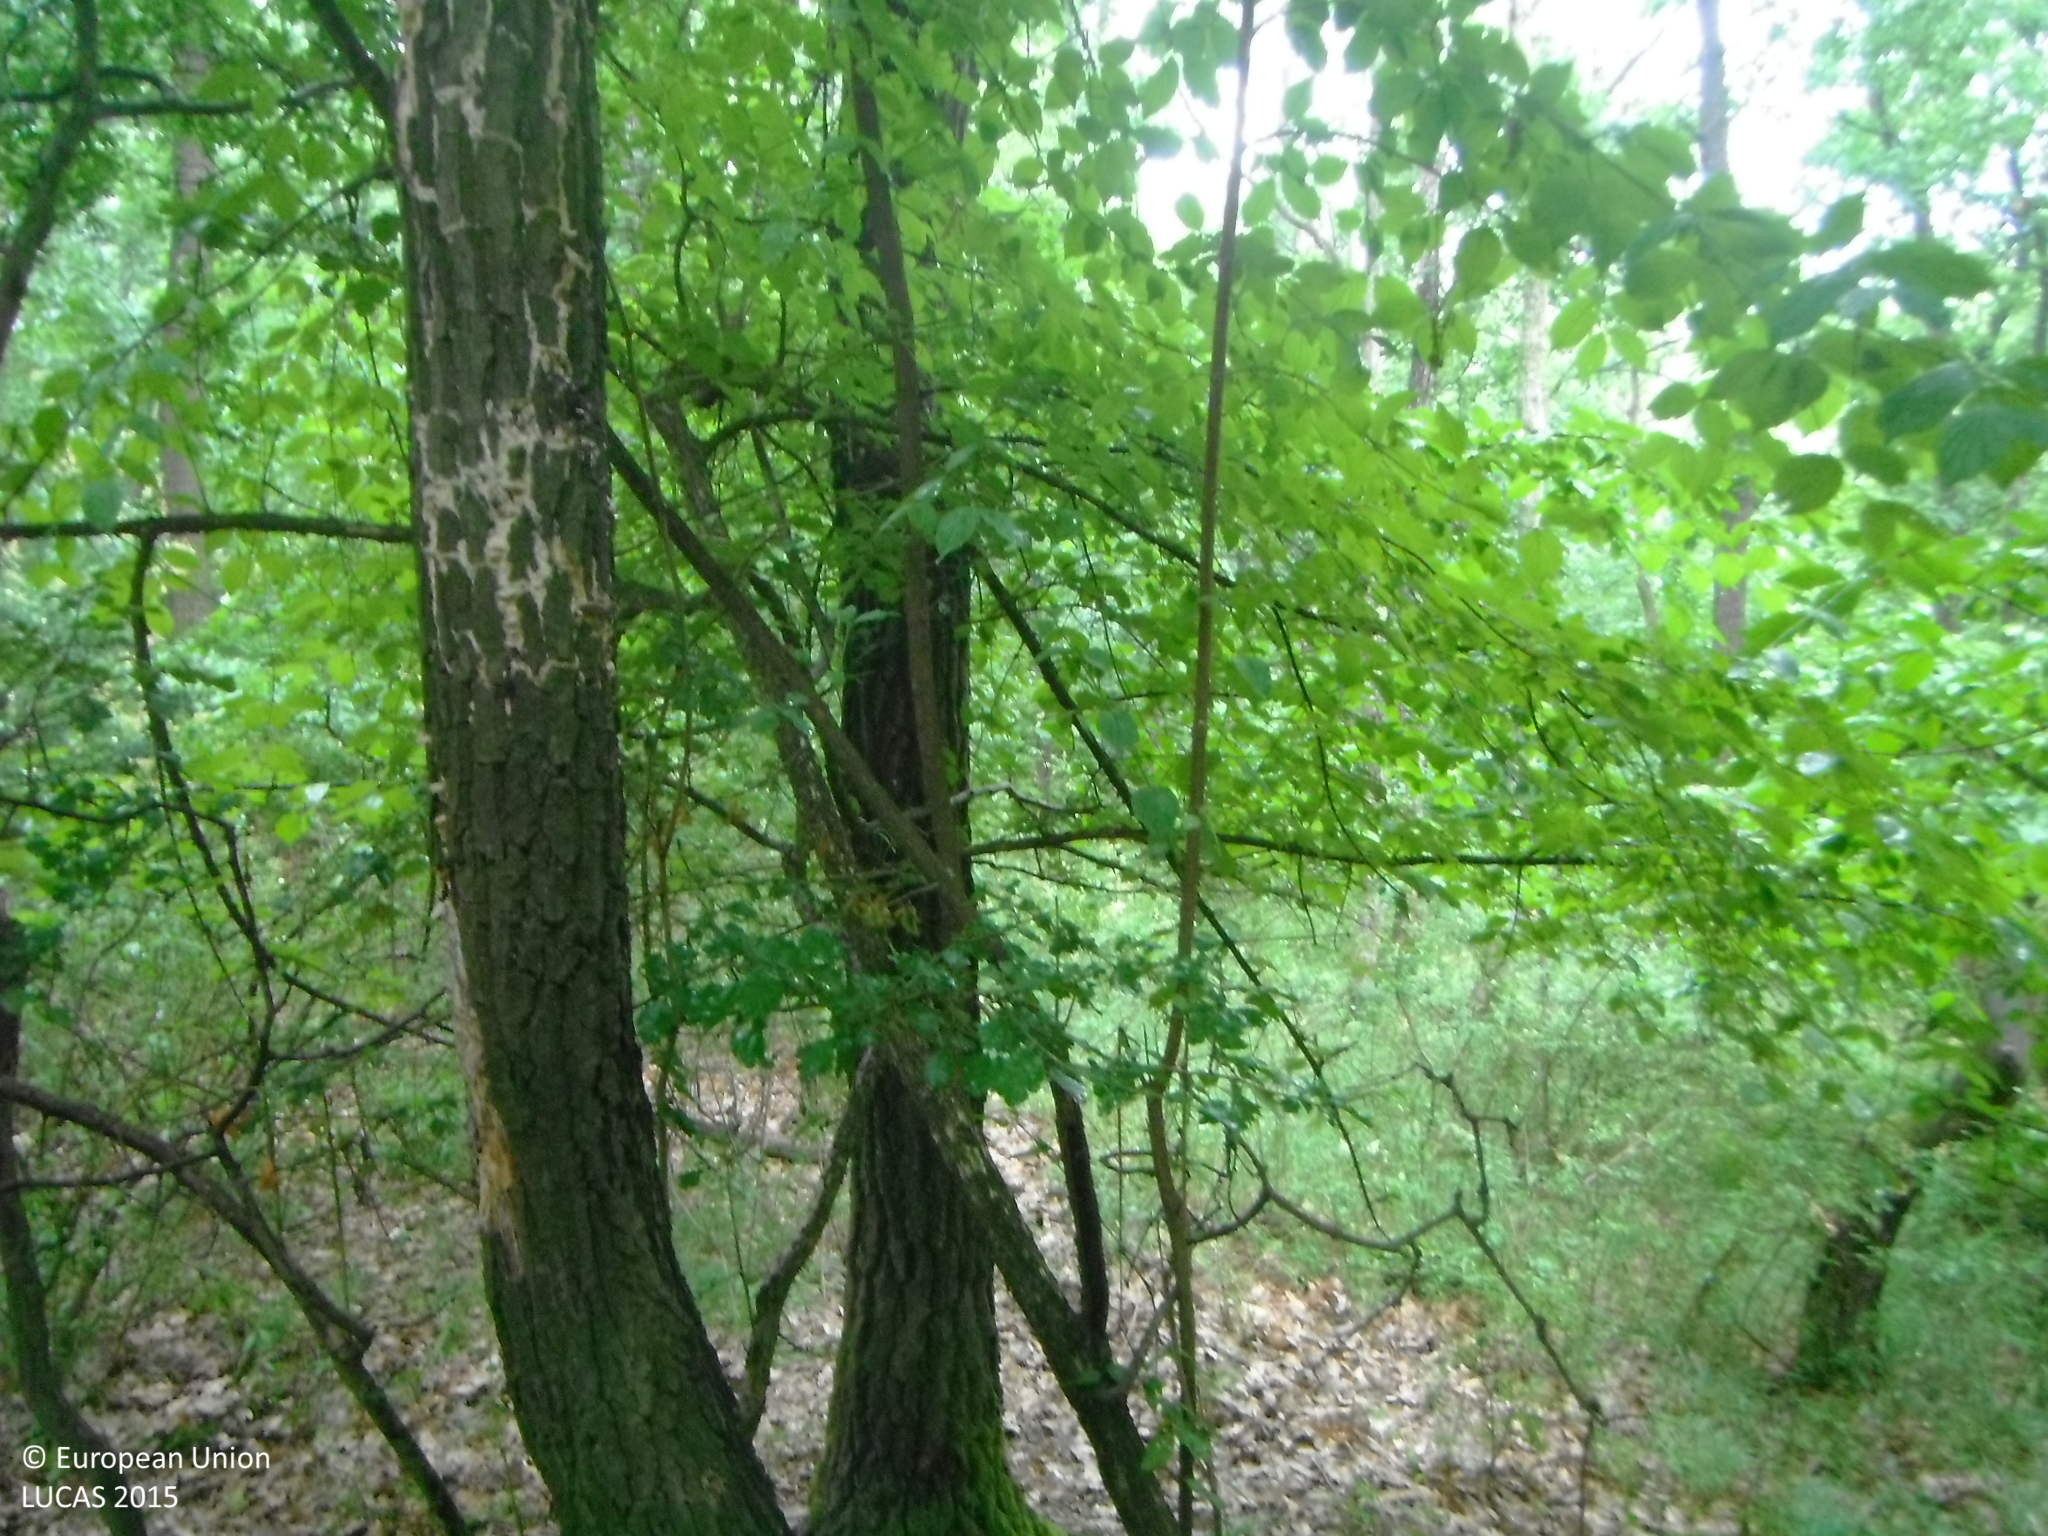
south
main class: Woodland
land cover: Broadleaved woodland
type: mesophytic deciduous forest
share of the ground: > 75 %
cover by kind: broadleaved forest trees 85 %, herbaceous plants 10 %, shrubs 5 %
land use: Forestry
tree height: > 5 m
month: June
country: SK
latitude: 48.7204
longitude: 18.3486
